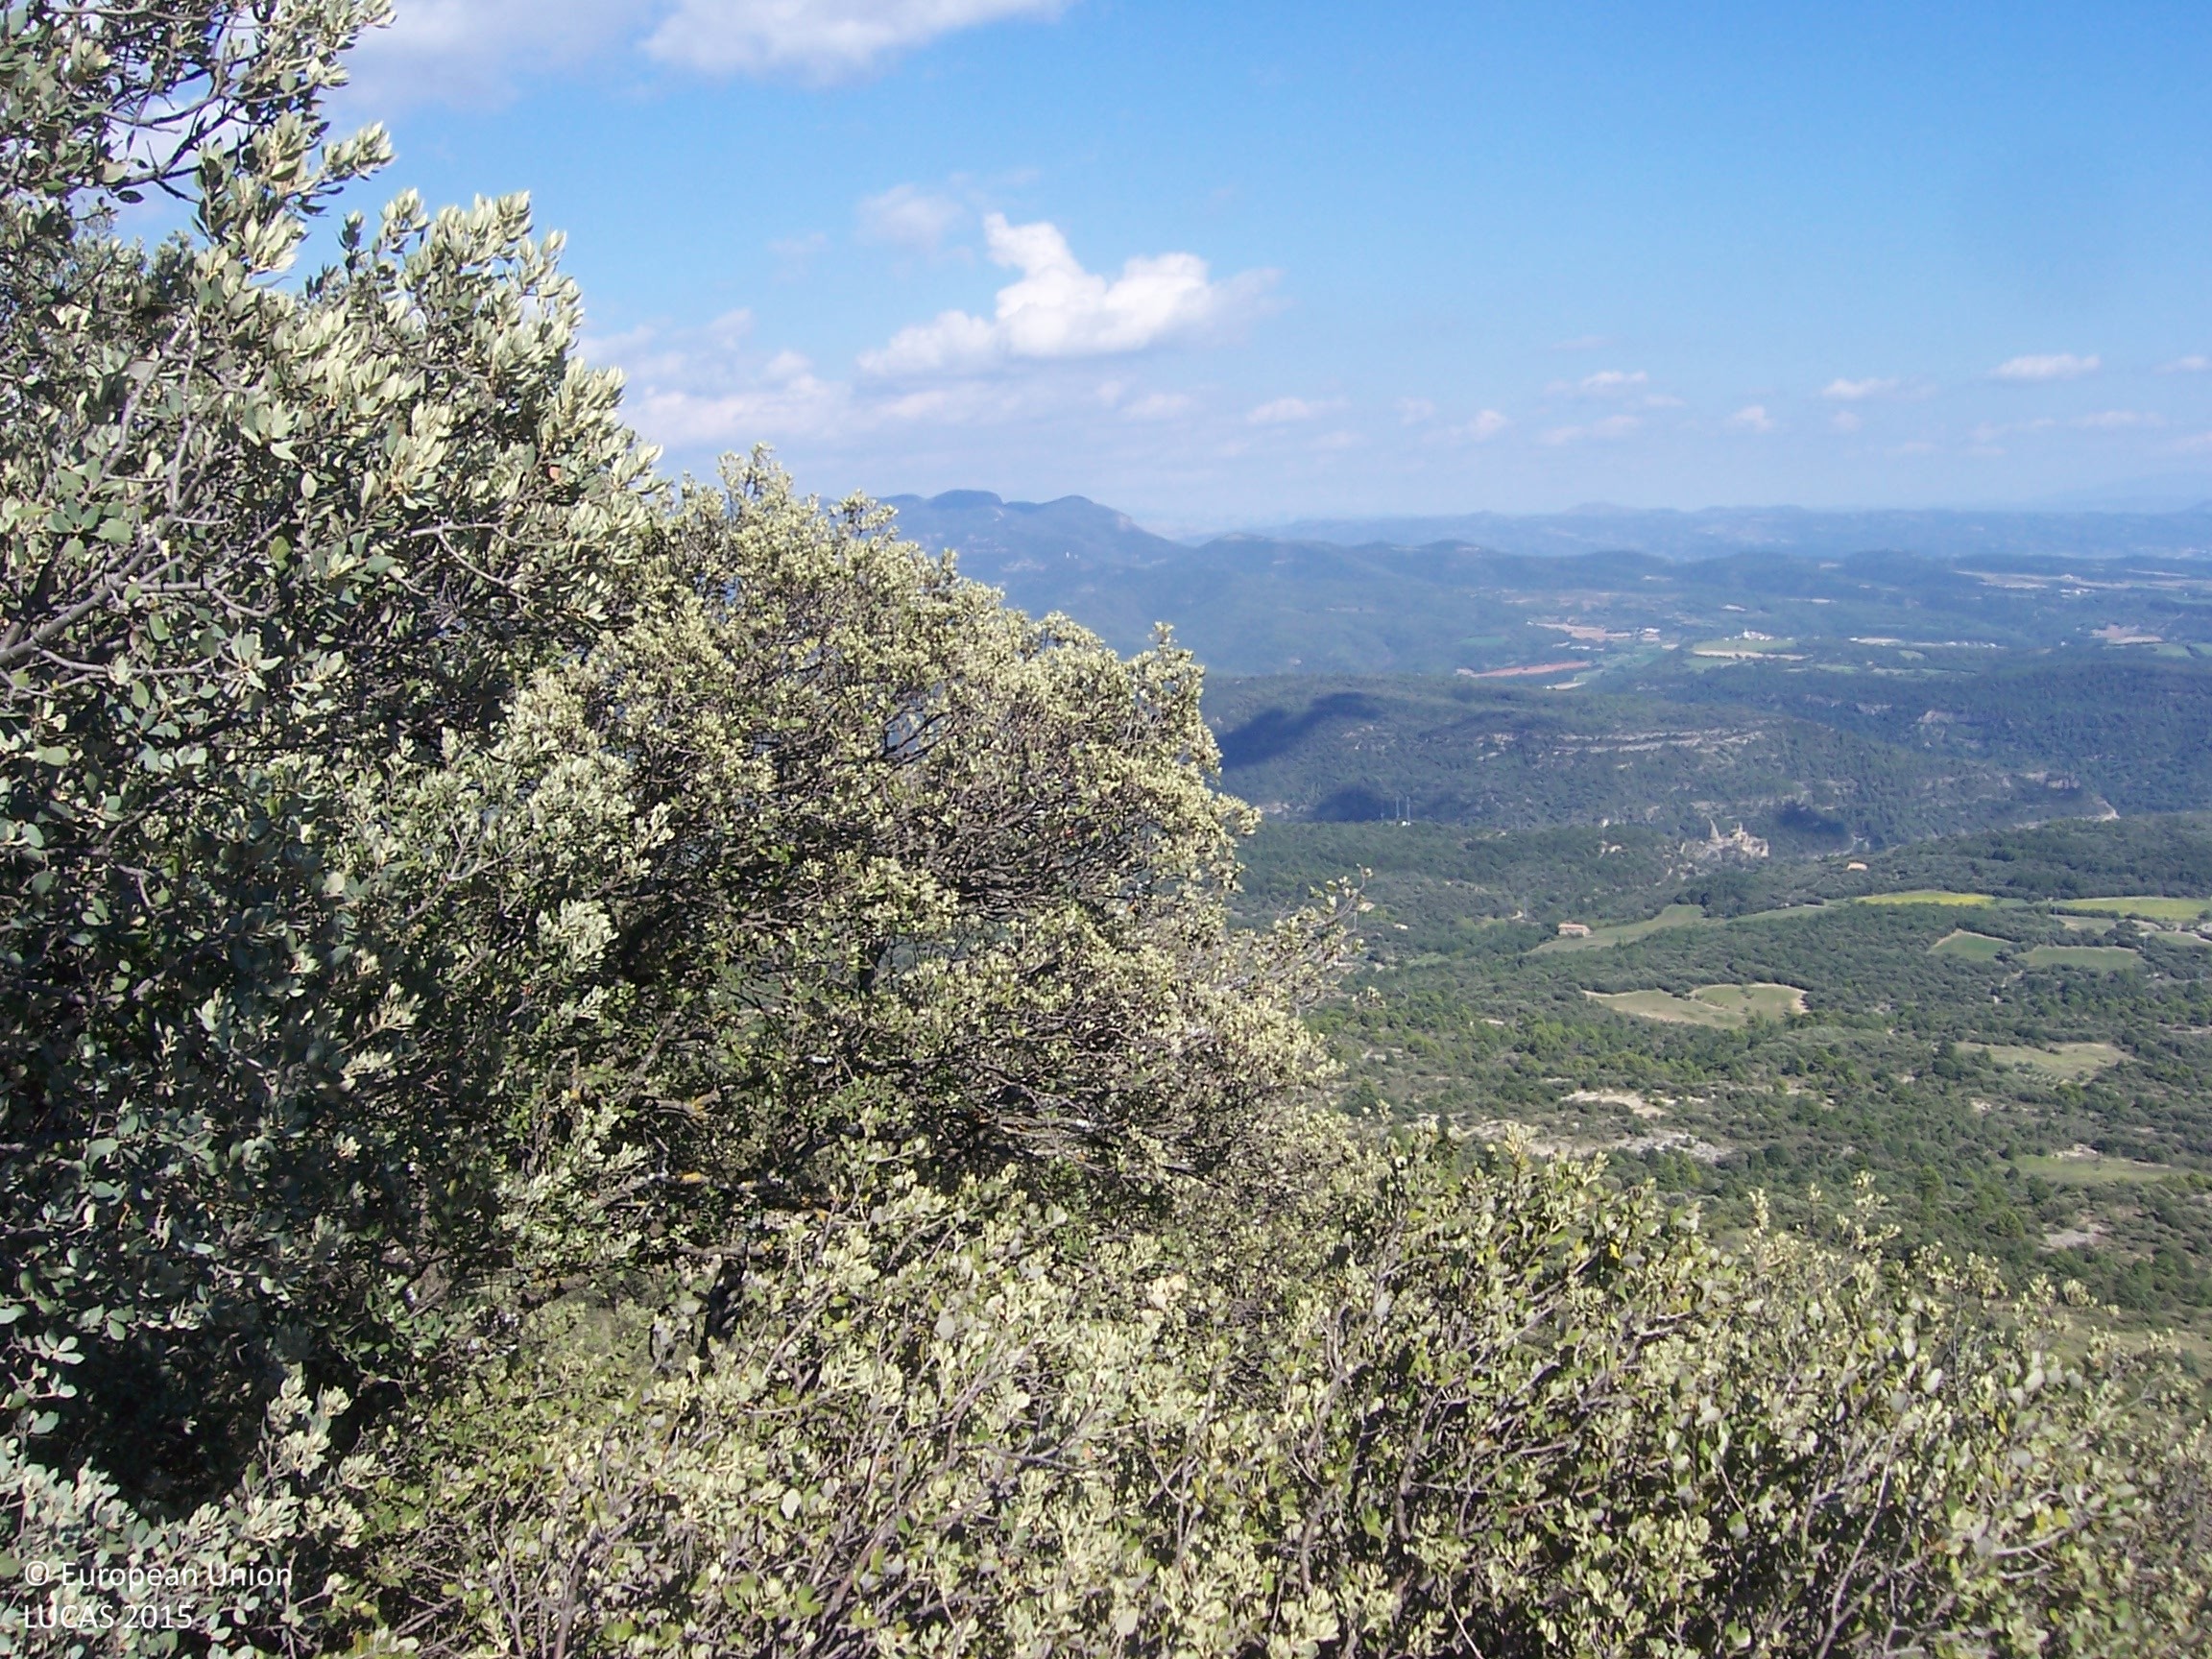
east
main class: Woodland
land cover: Broadleaved woodland
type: broadleaved evergreen forest
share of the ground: 25 - 50 %
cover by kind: broadleaved forest trees 30 %, shrubs 30 %, herbaceous plants 30 %, unconsolidated bare surface 10 %
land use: Semi-natural and natural areas not in use
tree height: < 5 m
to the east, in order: Broadleaved woodland
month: August
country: ES
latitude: 42.2799
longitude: 0.3164
